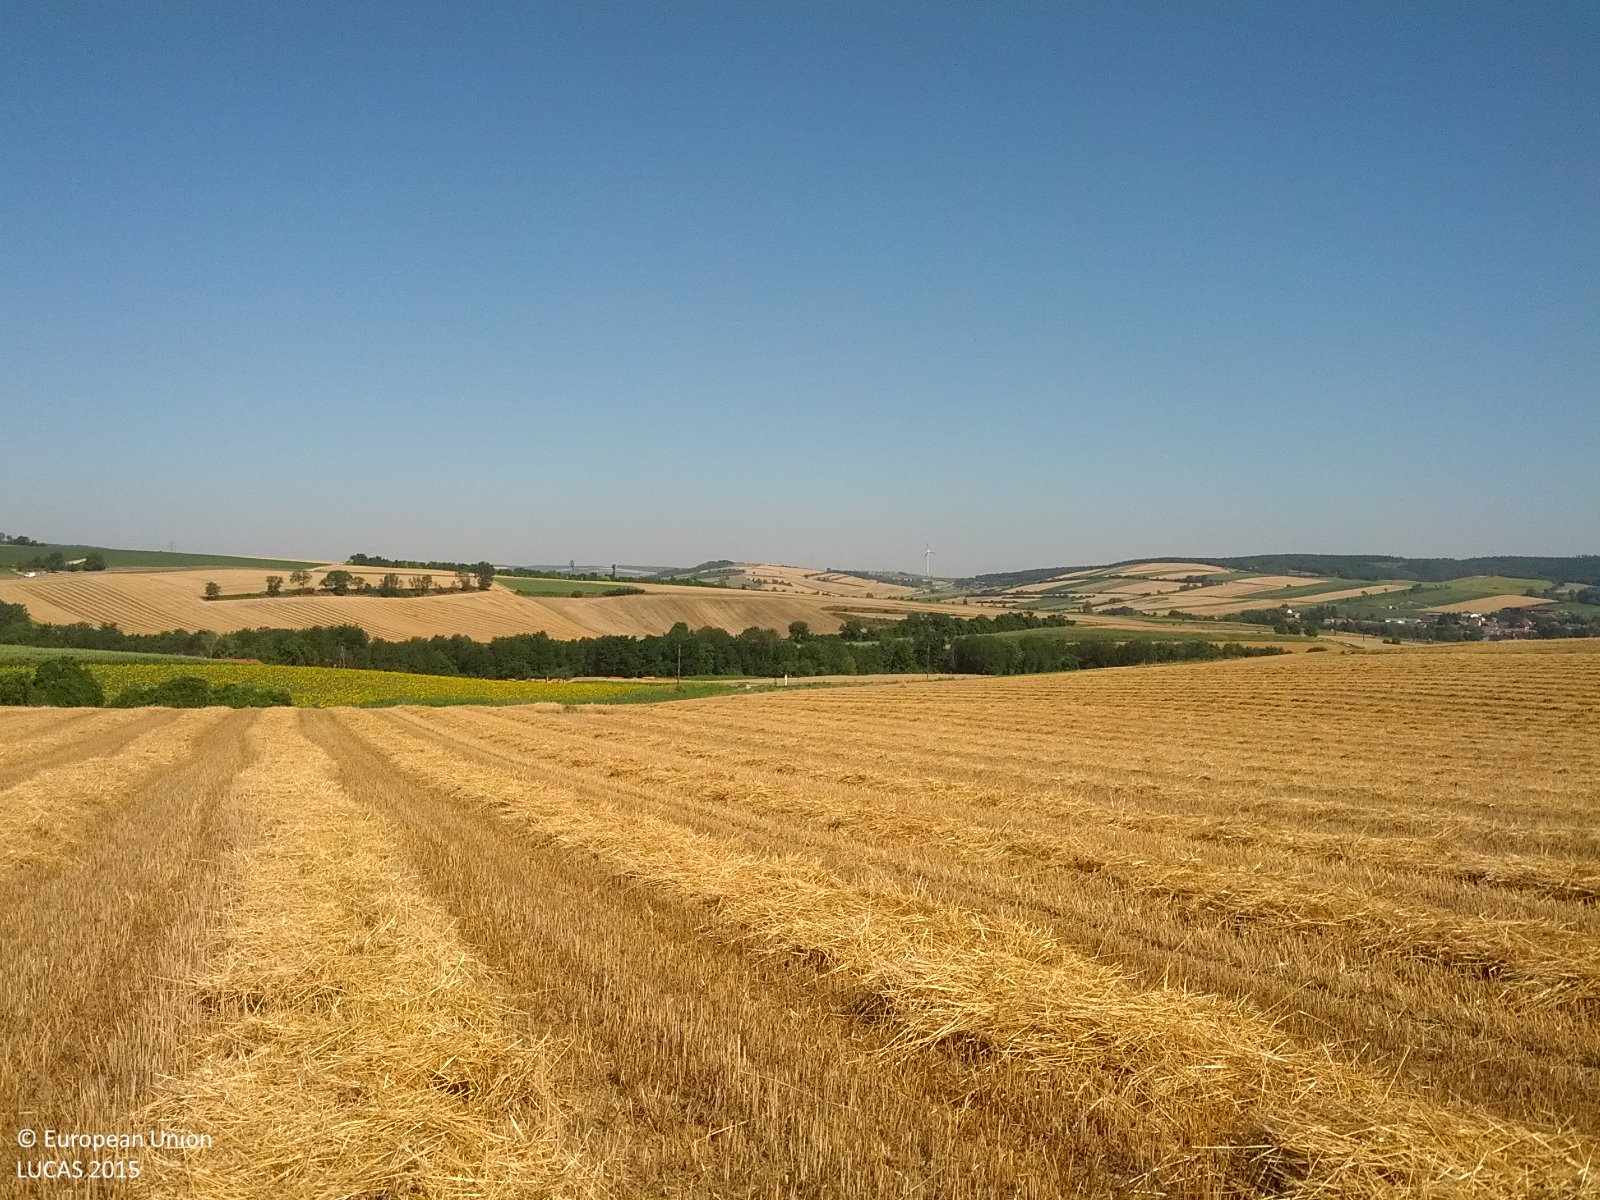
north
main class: Cropland
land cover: Common wheat
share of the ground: > 75 %
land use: Agriculture (excluding fallow land and kitchen gardens)
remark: Harvested field
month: July
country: AT
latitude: 48.4873
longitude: 16.1067
